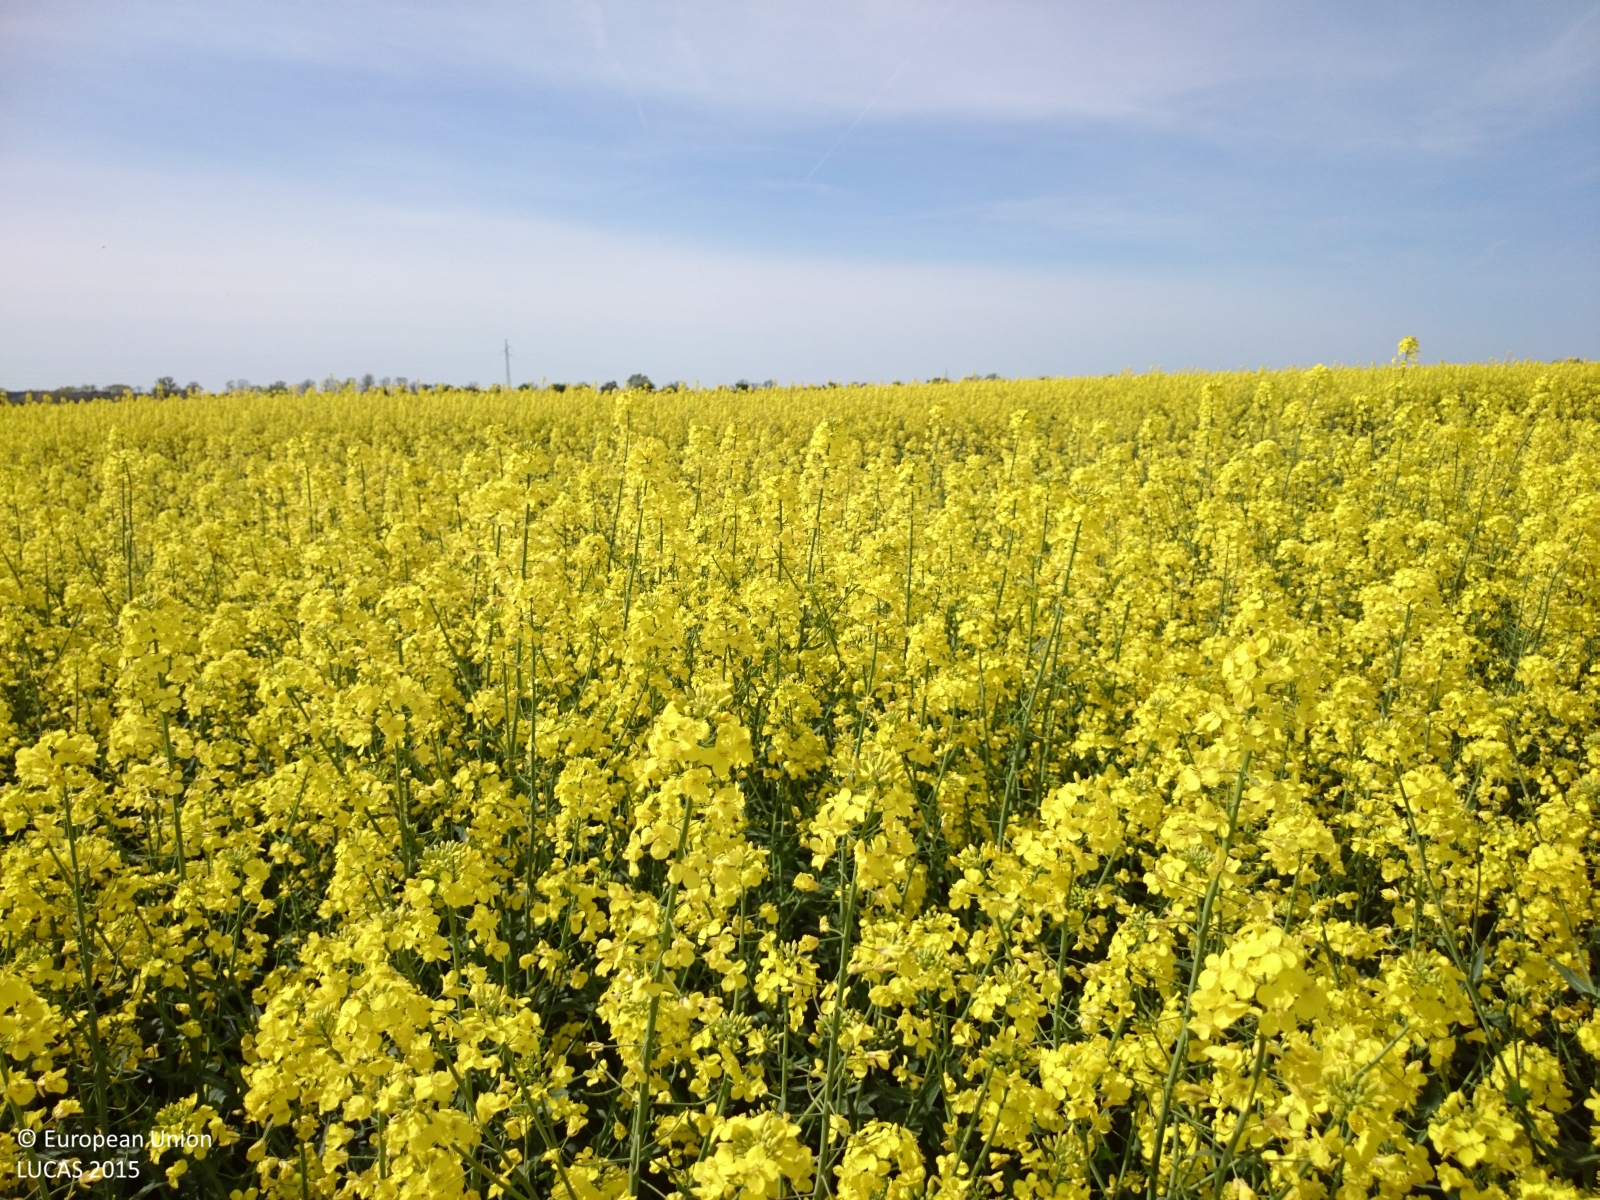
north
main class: Cropland
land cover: Rape and turnip rape
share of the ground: > 75 %
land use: Agriculture (excluding fallow land and kitchen gardens)
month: May
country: PL
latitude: 52.5704
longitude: 16.3068
